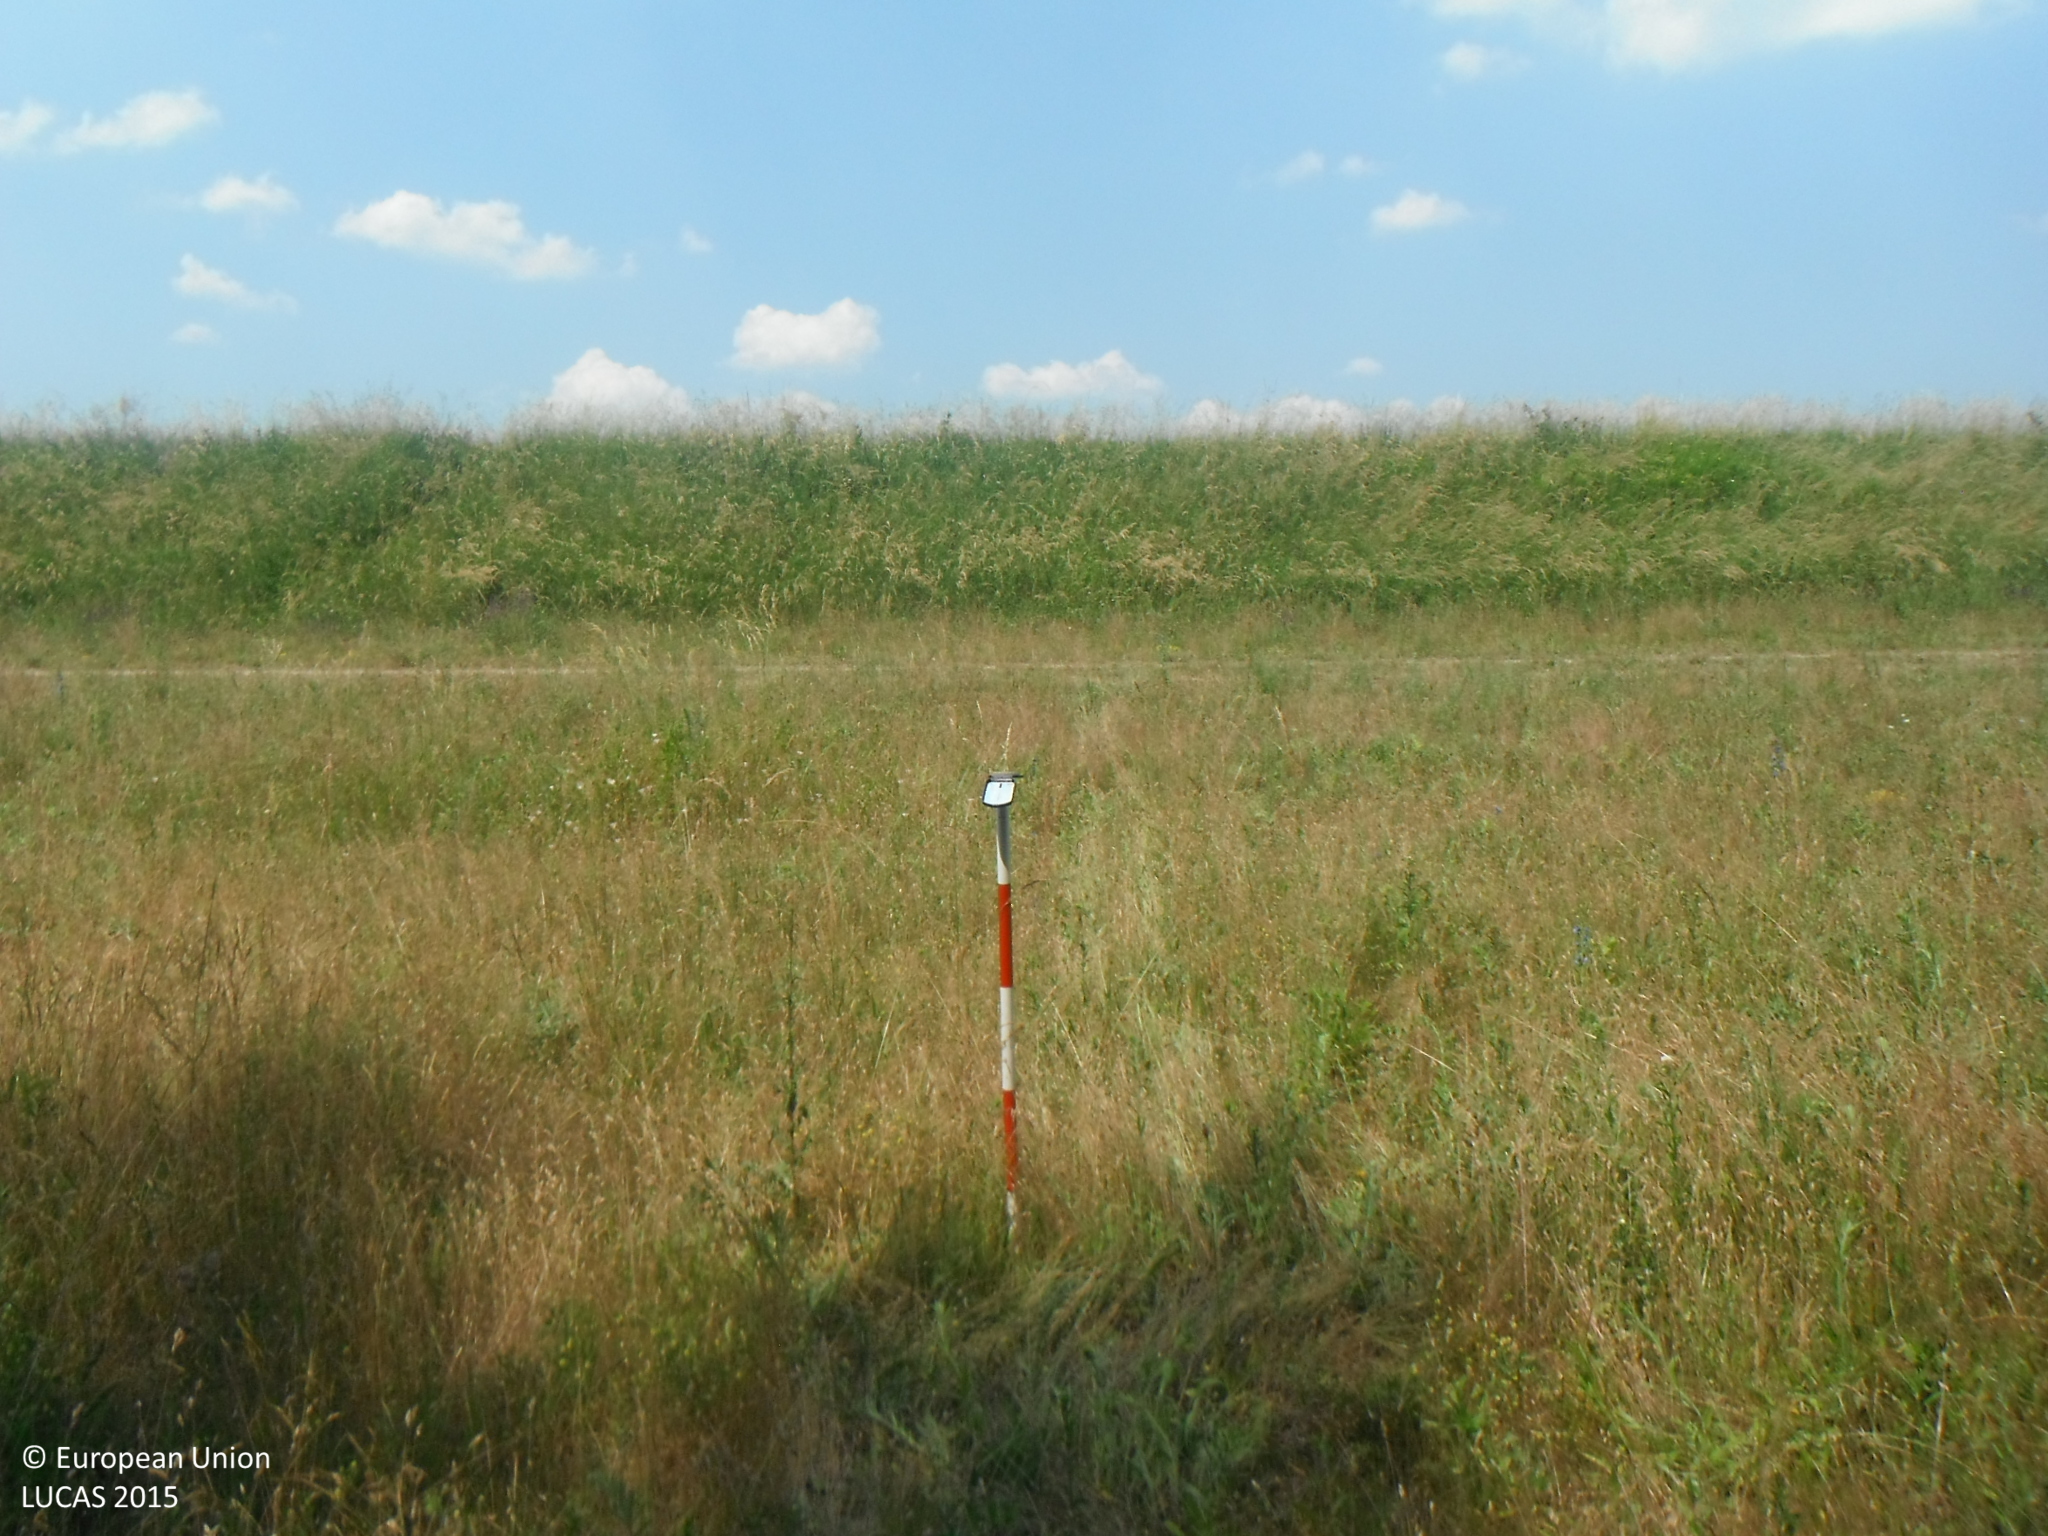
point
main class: Grassland
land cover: Grassland without tree/shrub cover
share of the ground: > 75 %
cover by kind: herbaceous plants 100 %
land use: Agriculture (excluding fallow land and kitchen gardens)
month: June
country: SK
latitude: 47.7516
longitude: 18.0015
